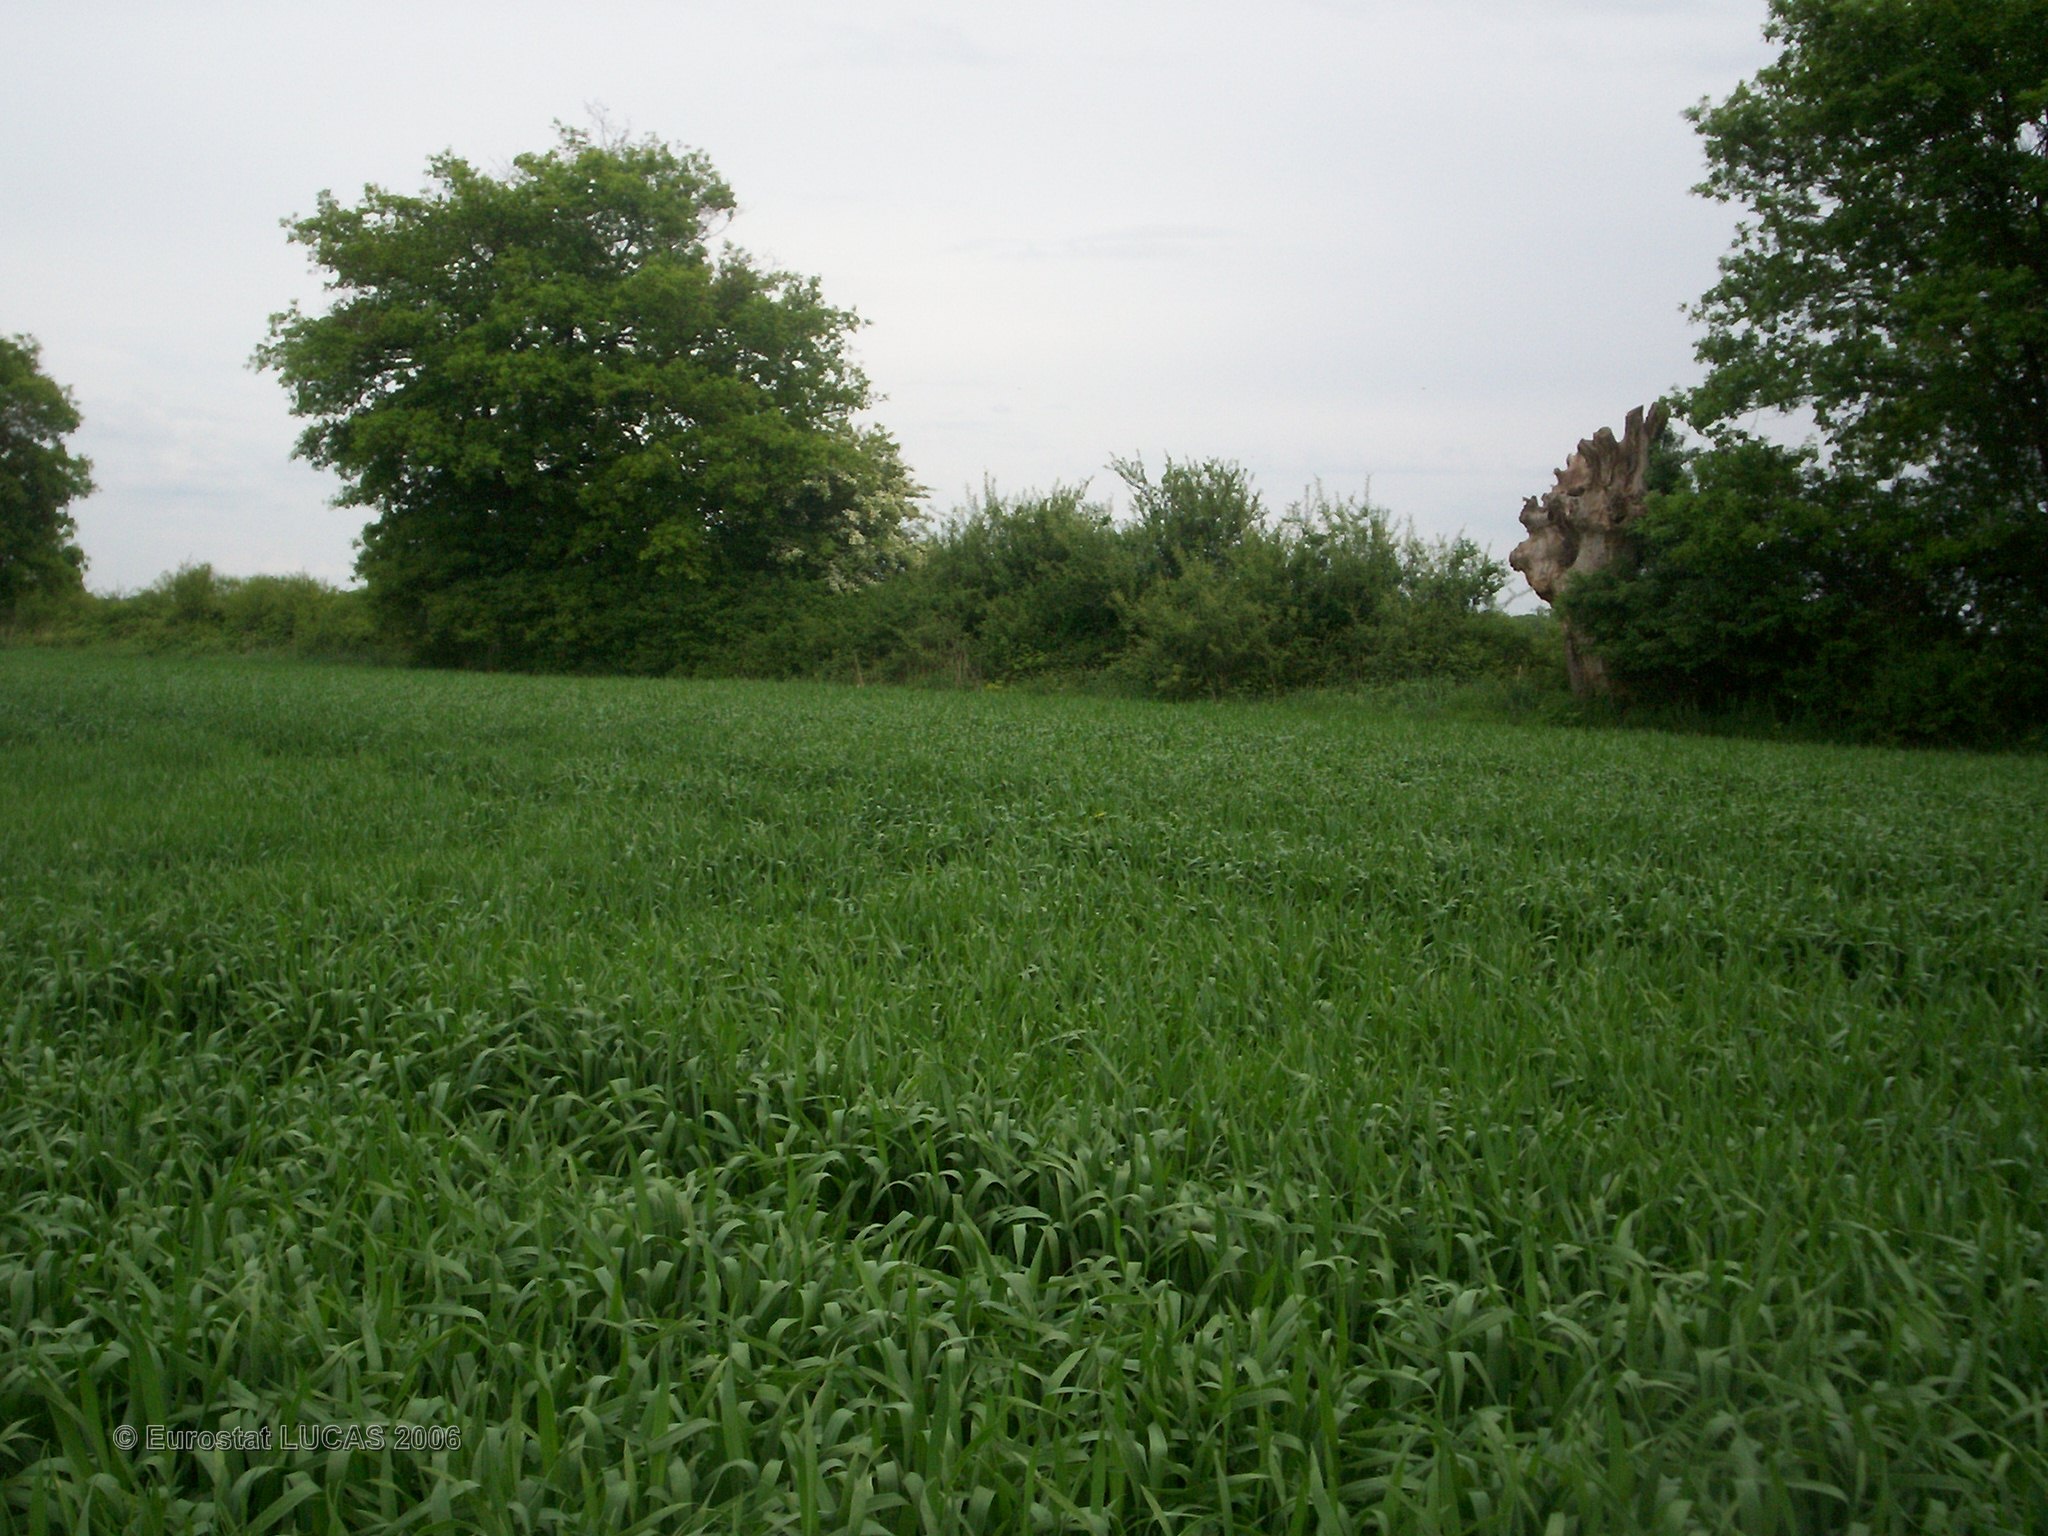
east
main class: Cropland
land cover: Common wheat
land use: Agriculture (excluding fallow land and kitchen gardens)
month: May
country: FR
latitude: 47.6955
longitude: 3.0251
